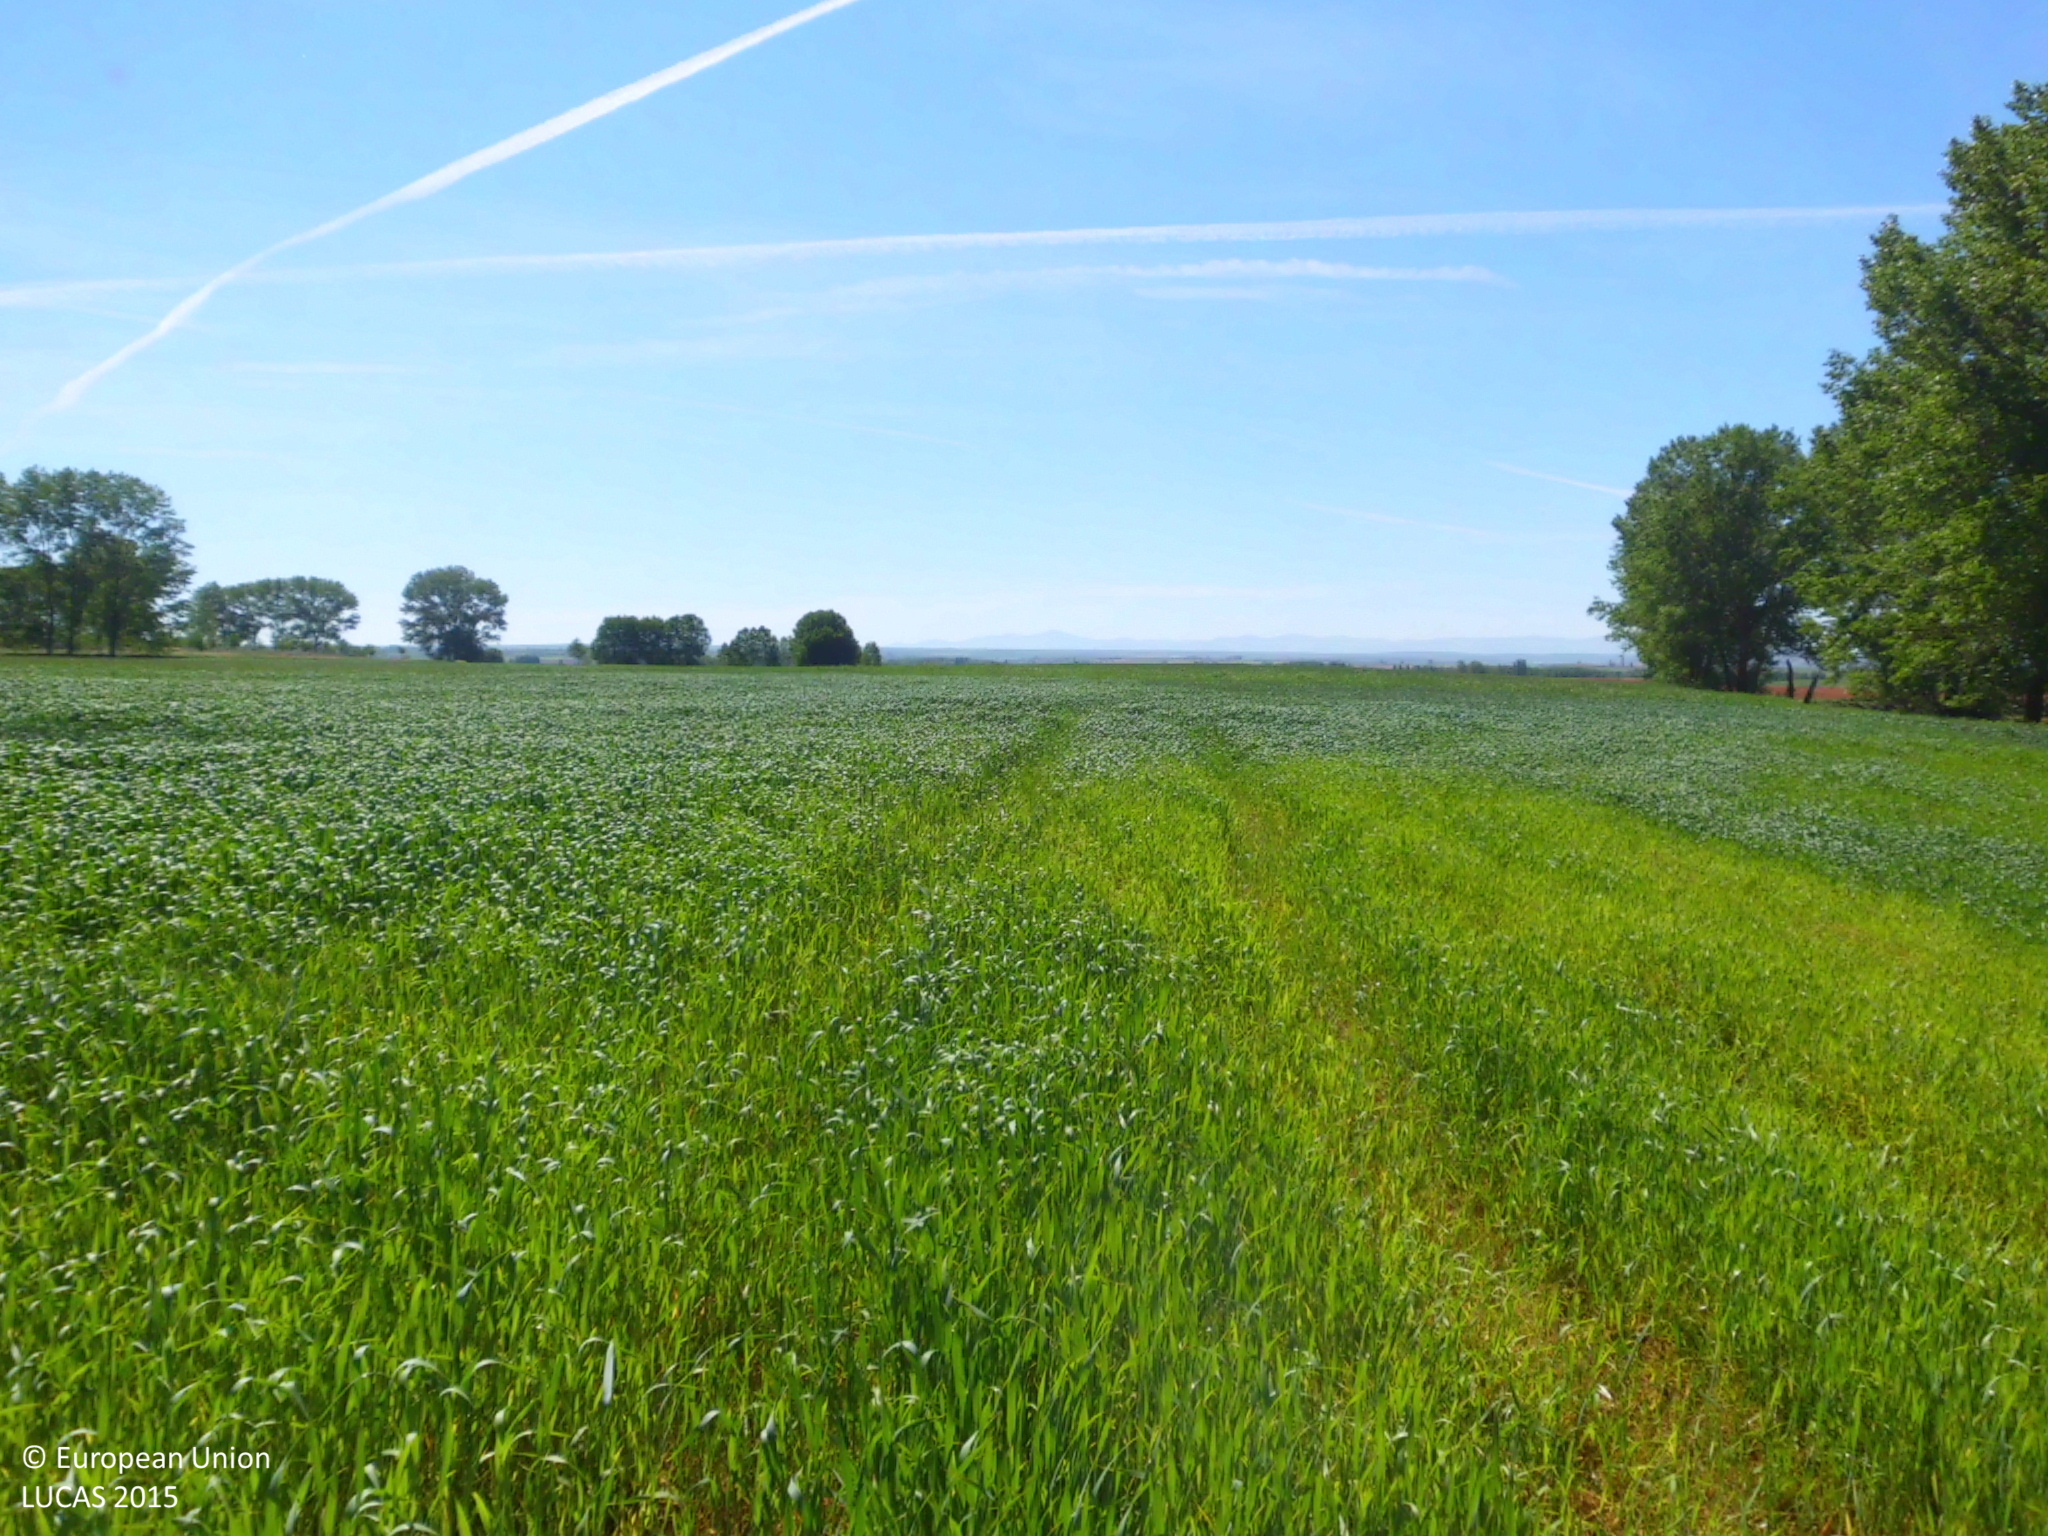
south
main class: Cropland
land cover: Common wheat
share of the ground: 50 - 75 %
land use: Agriculture (excluding fallow land and kitchen gardens)
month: May
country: ES
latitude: 42.6590
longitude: -3.3686
